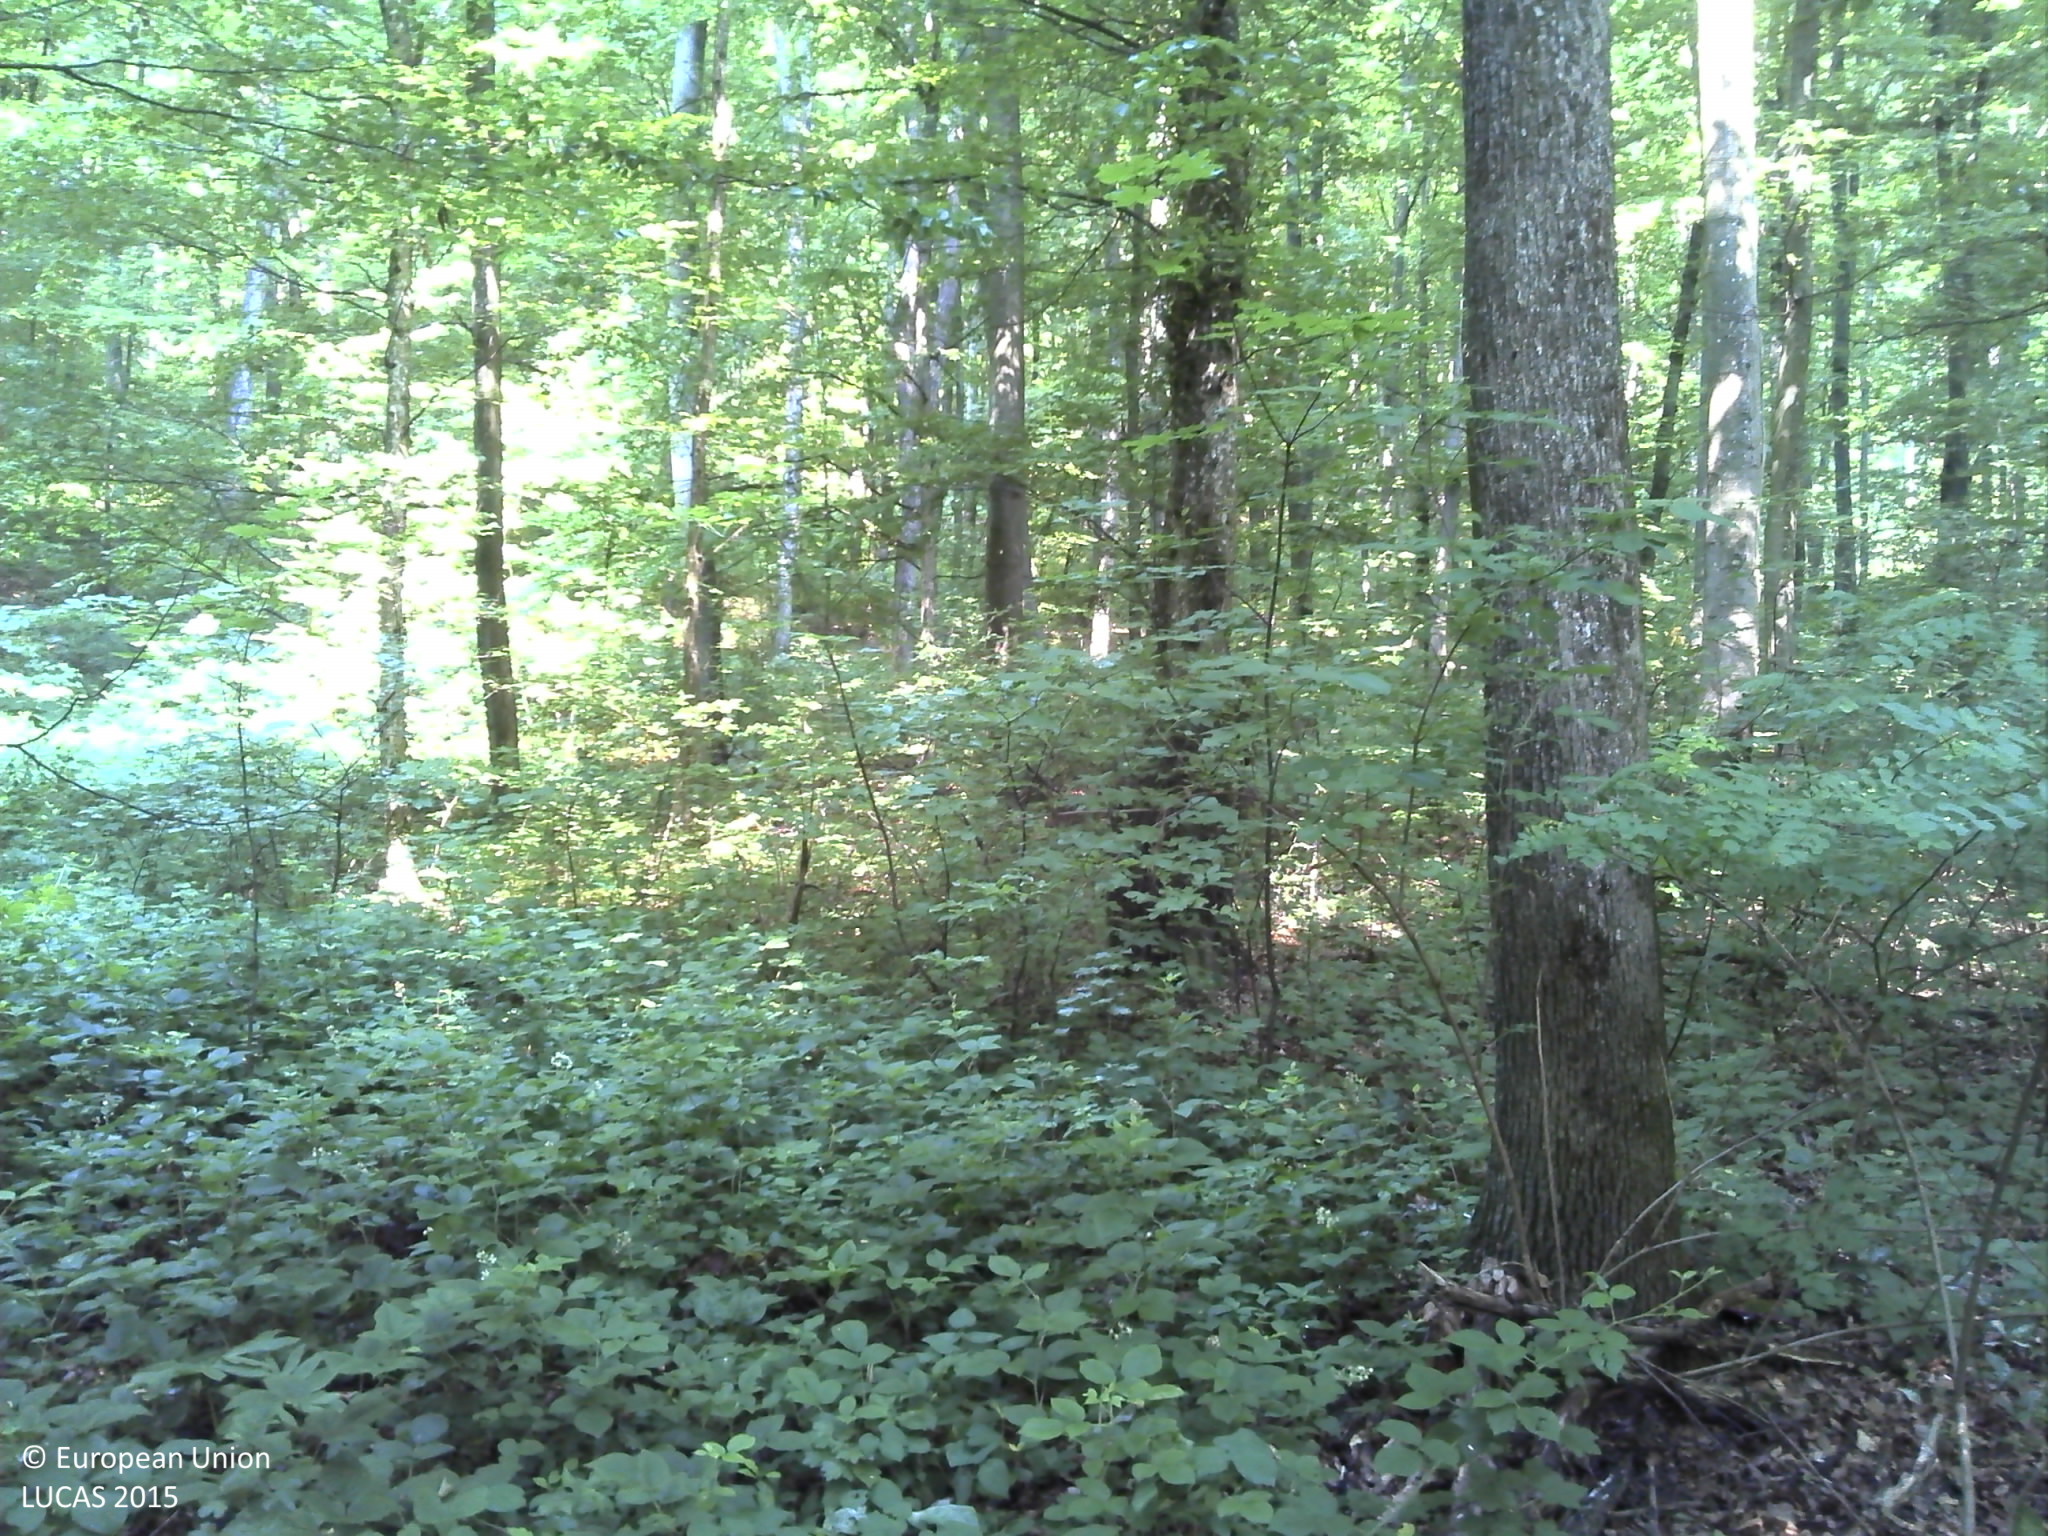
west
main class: Woodland
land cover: Broadleaved woodland
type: beech forest
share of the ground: > 75 %
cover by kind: broadleaved forest trees 90 %, shrubs 5 %, lichens and mosses 5 %
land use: Forestry
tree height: > 5 m
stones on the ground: < 10 %
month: June
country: HR
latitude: 45.2418
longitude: 18.1696
